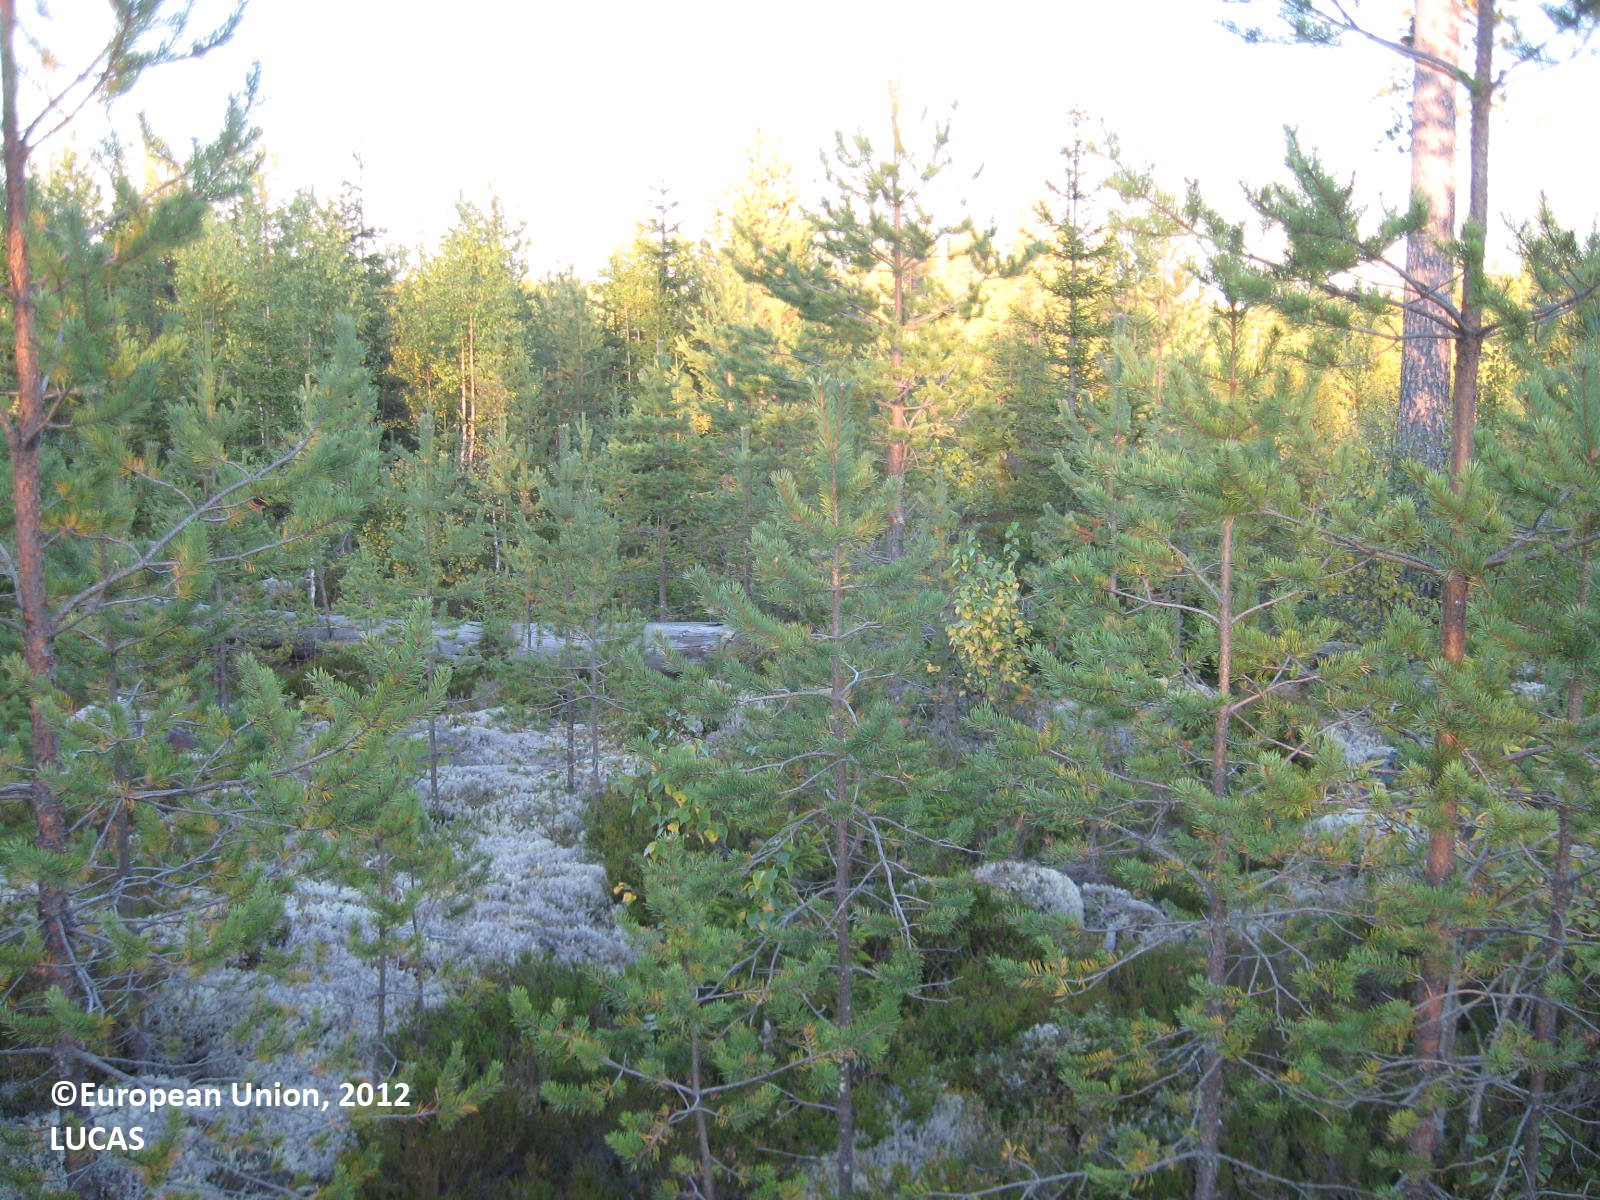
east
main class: Woodland
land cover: Pine dominated coniferous woodland
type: boreal forest
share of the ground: 50 - 75 %
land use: Forestry
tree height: < 5 m
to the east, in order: Pine dominated coniferous woodland
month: August
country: FI
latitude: 63.8445
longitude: 29.7737
